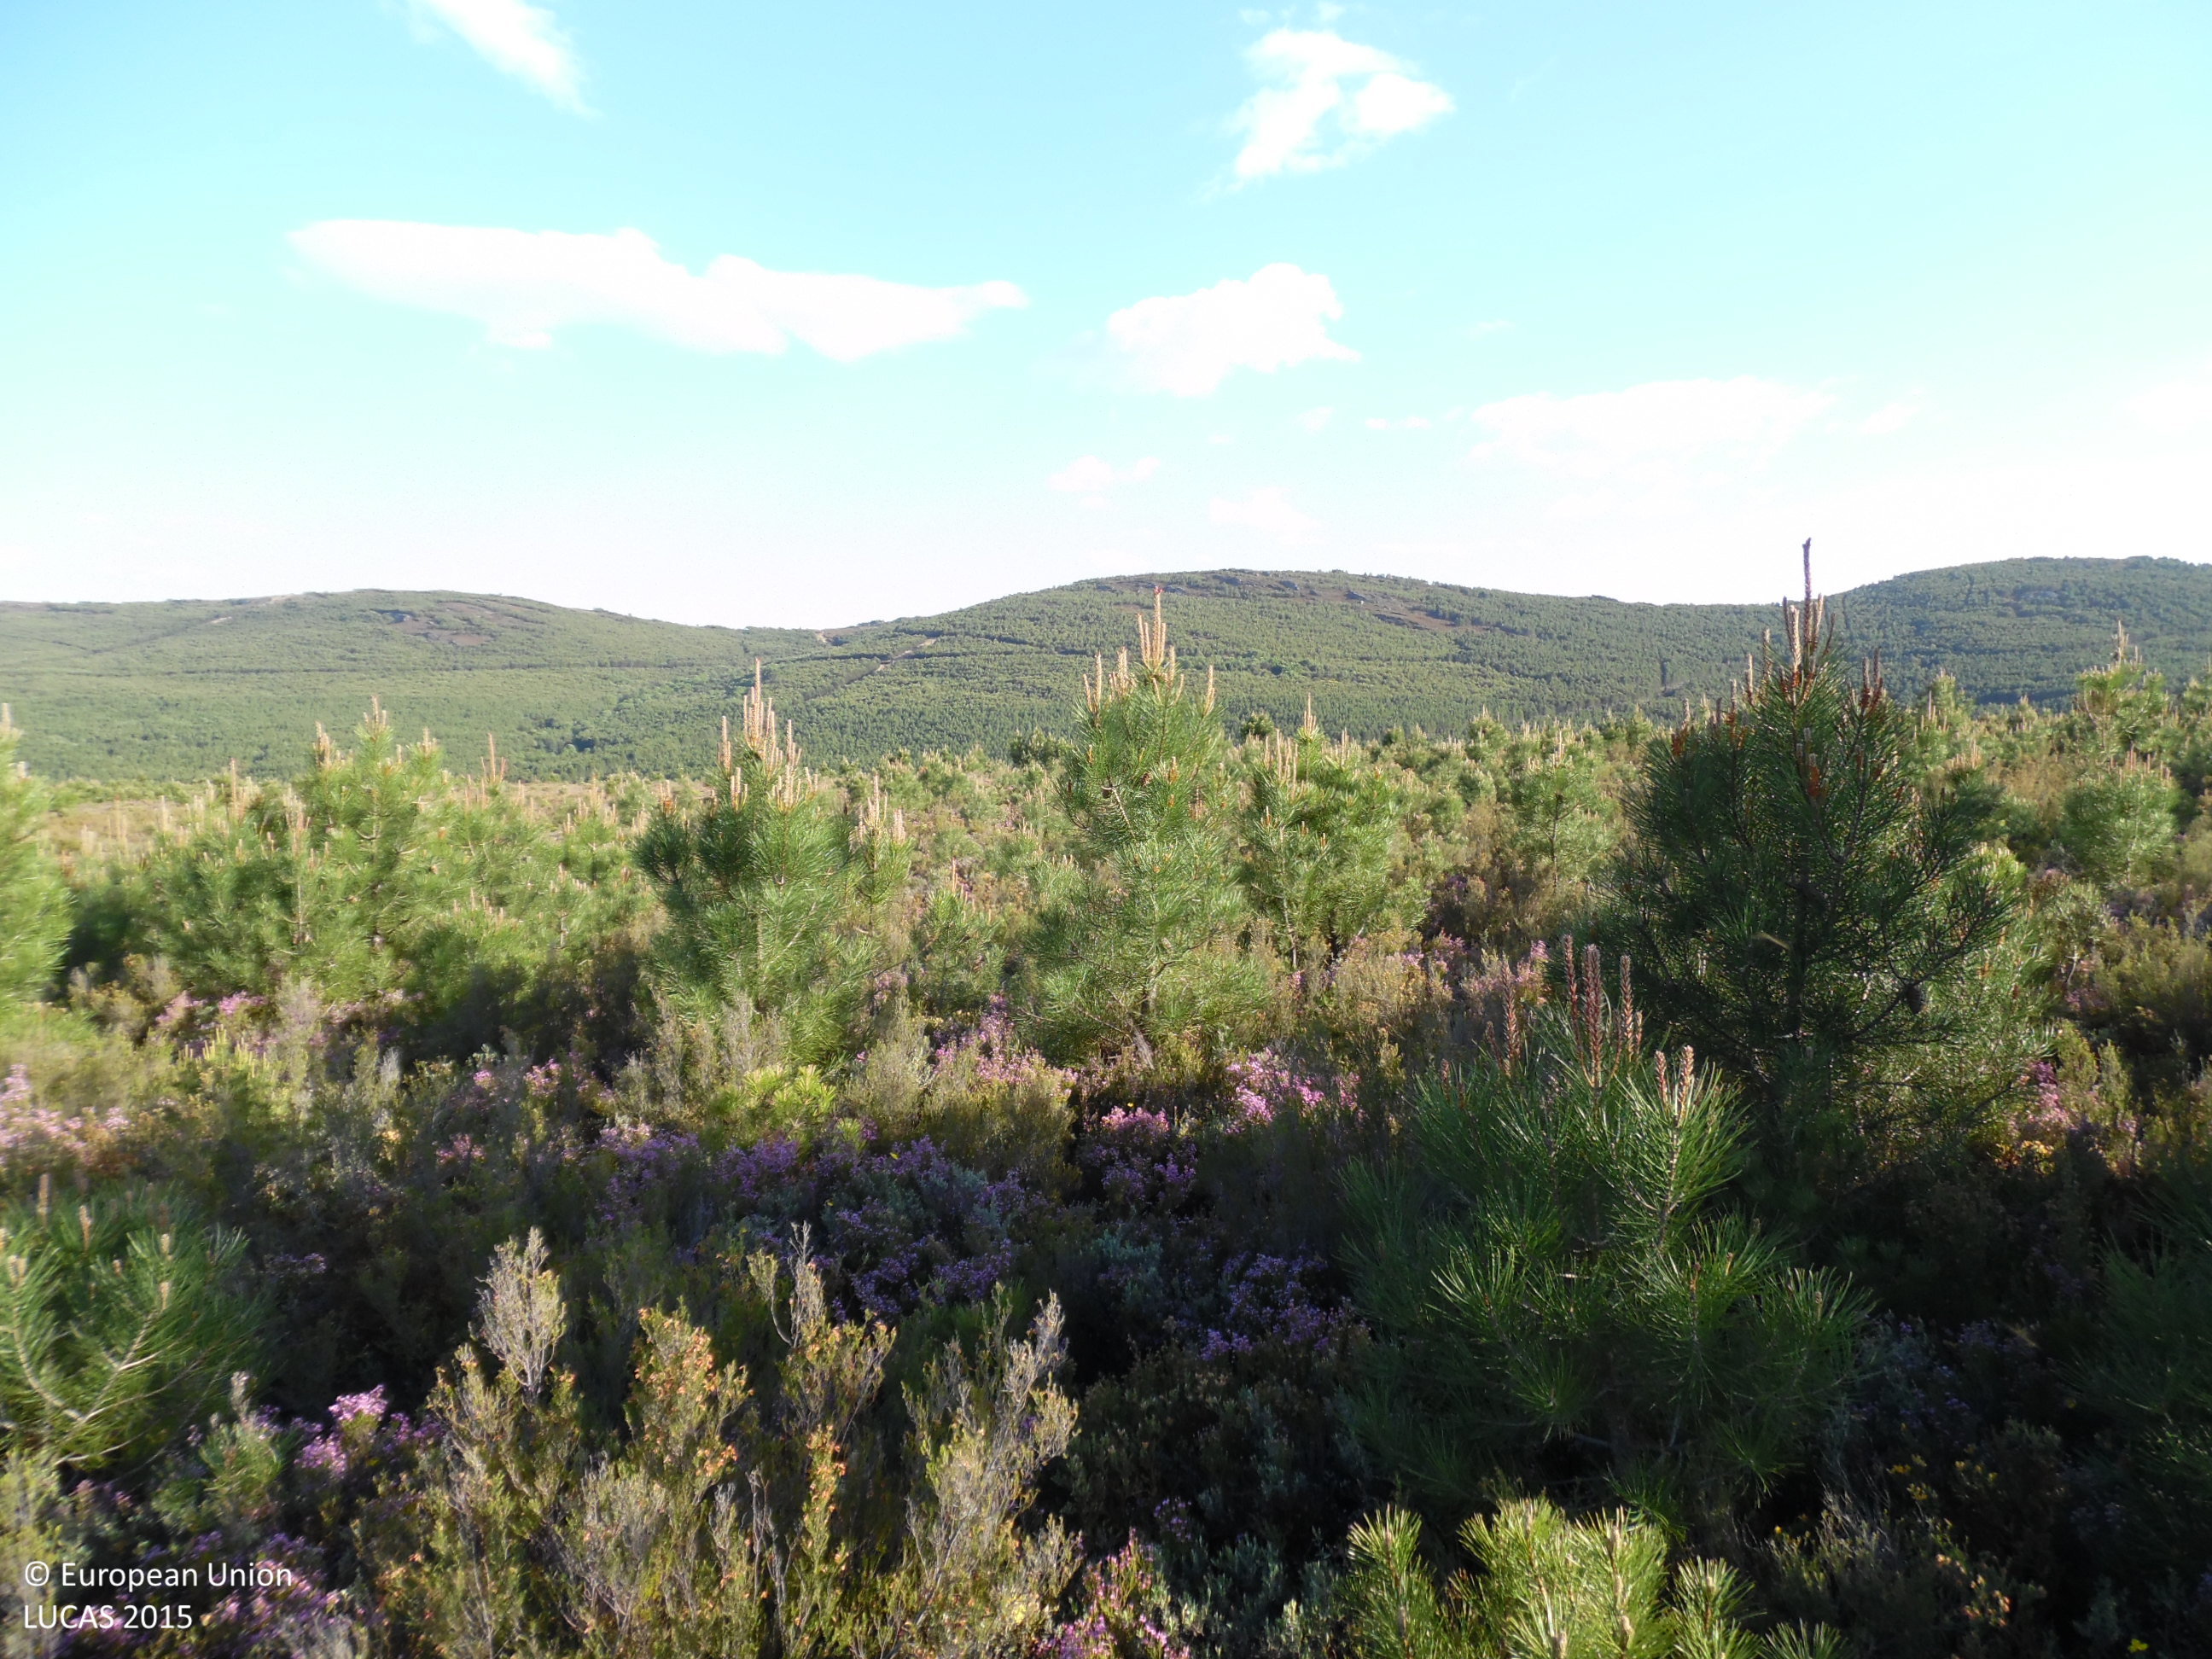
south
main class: Woodland
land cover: Pine dominated coniferous woodland
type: coniferous forest of the mediterranean region
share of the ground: 25 - 50 %
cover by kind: shrubs 55 %, coniferous forest trees 45 %
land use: Forestry
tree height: < 5 m
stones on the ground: 10 - 25 %
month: May
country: ES
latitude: 42.1918
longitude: -6.2731
